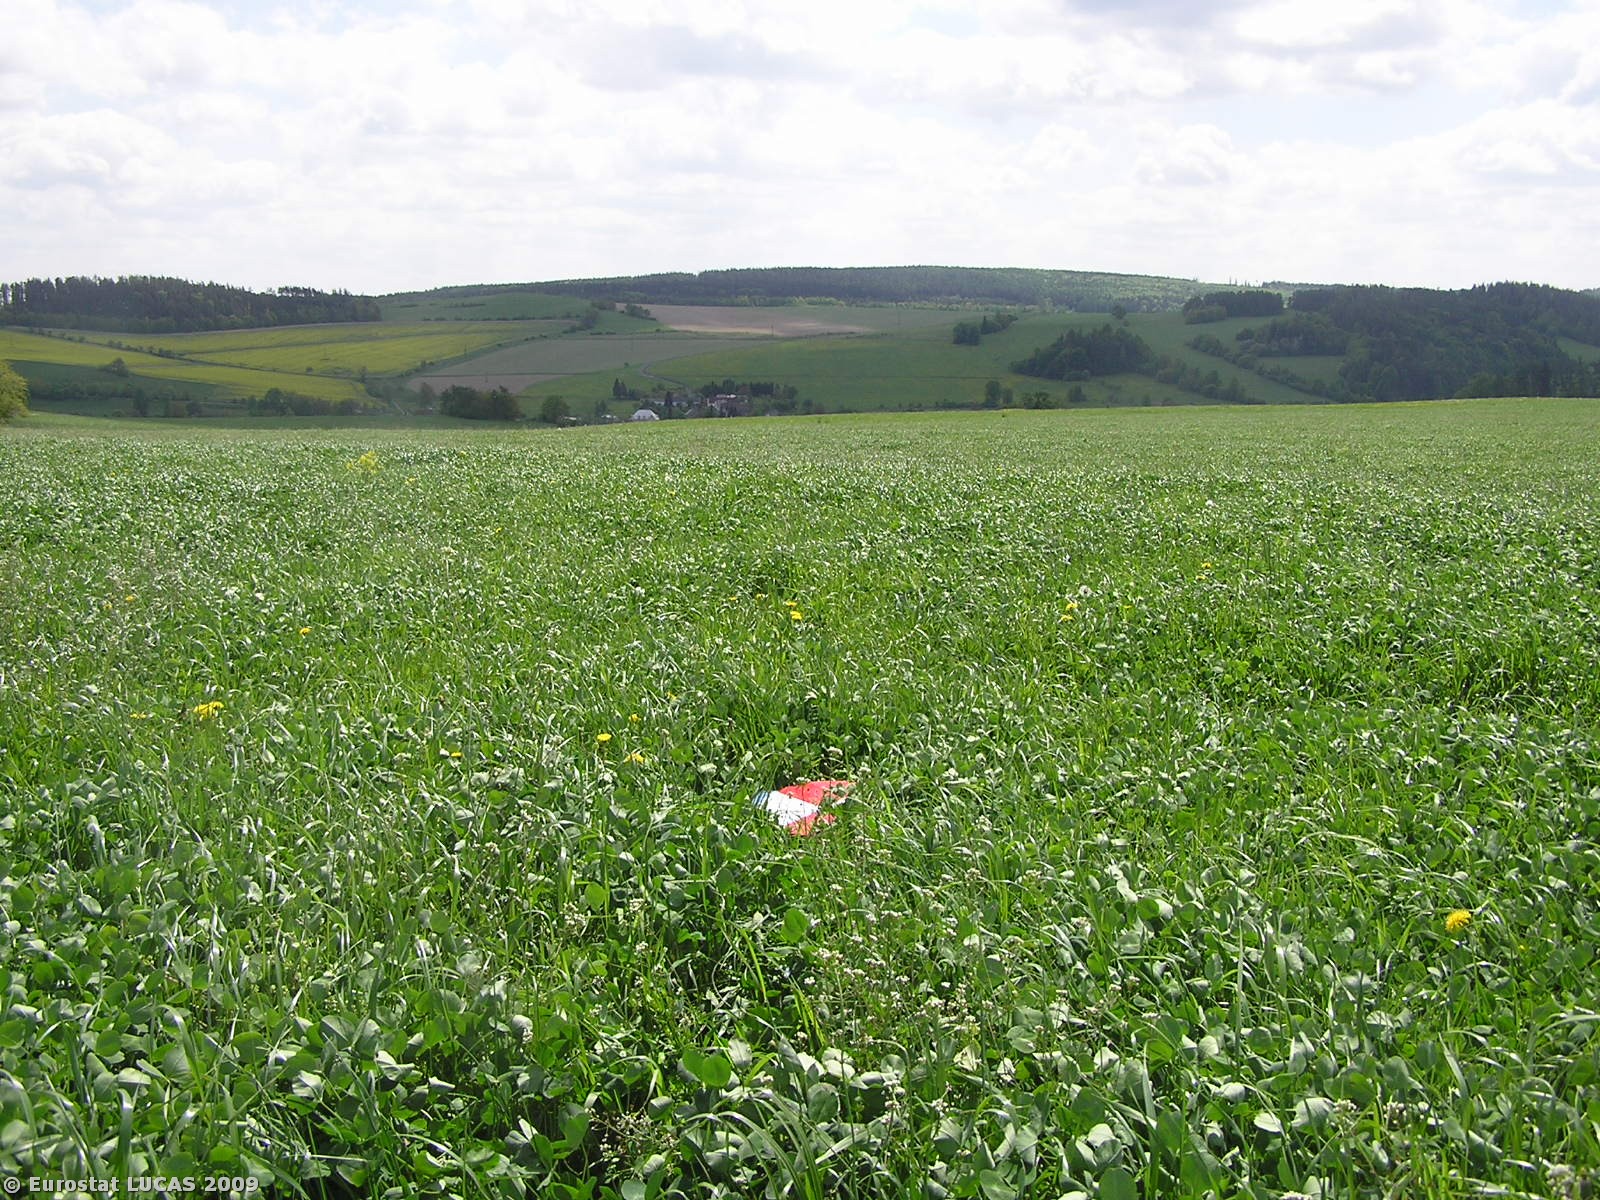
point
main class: Cropland
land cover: Clovers
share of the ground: > 75 %
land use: Agriculture (excluding fallow land and kitchen gardens)
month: May
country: CZ
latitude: 50.0194
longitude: 17.6195
